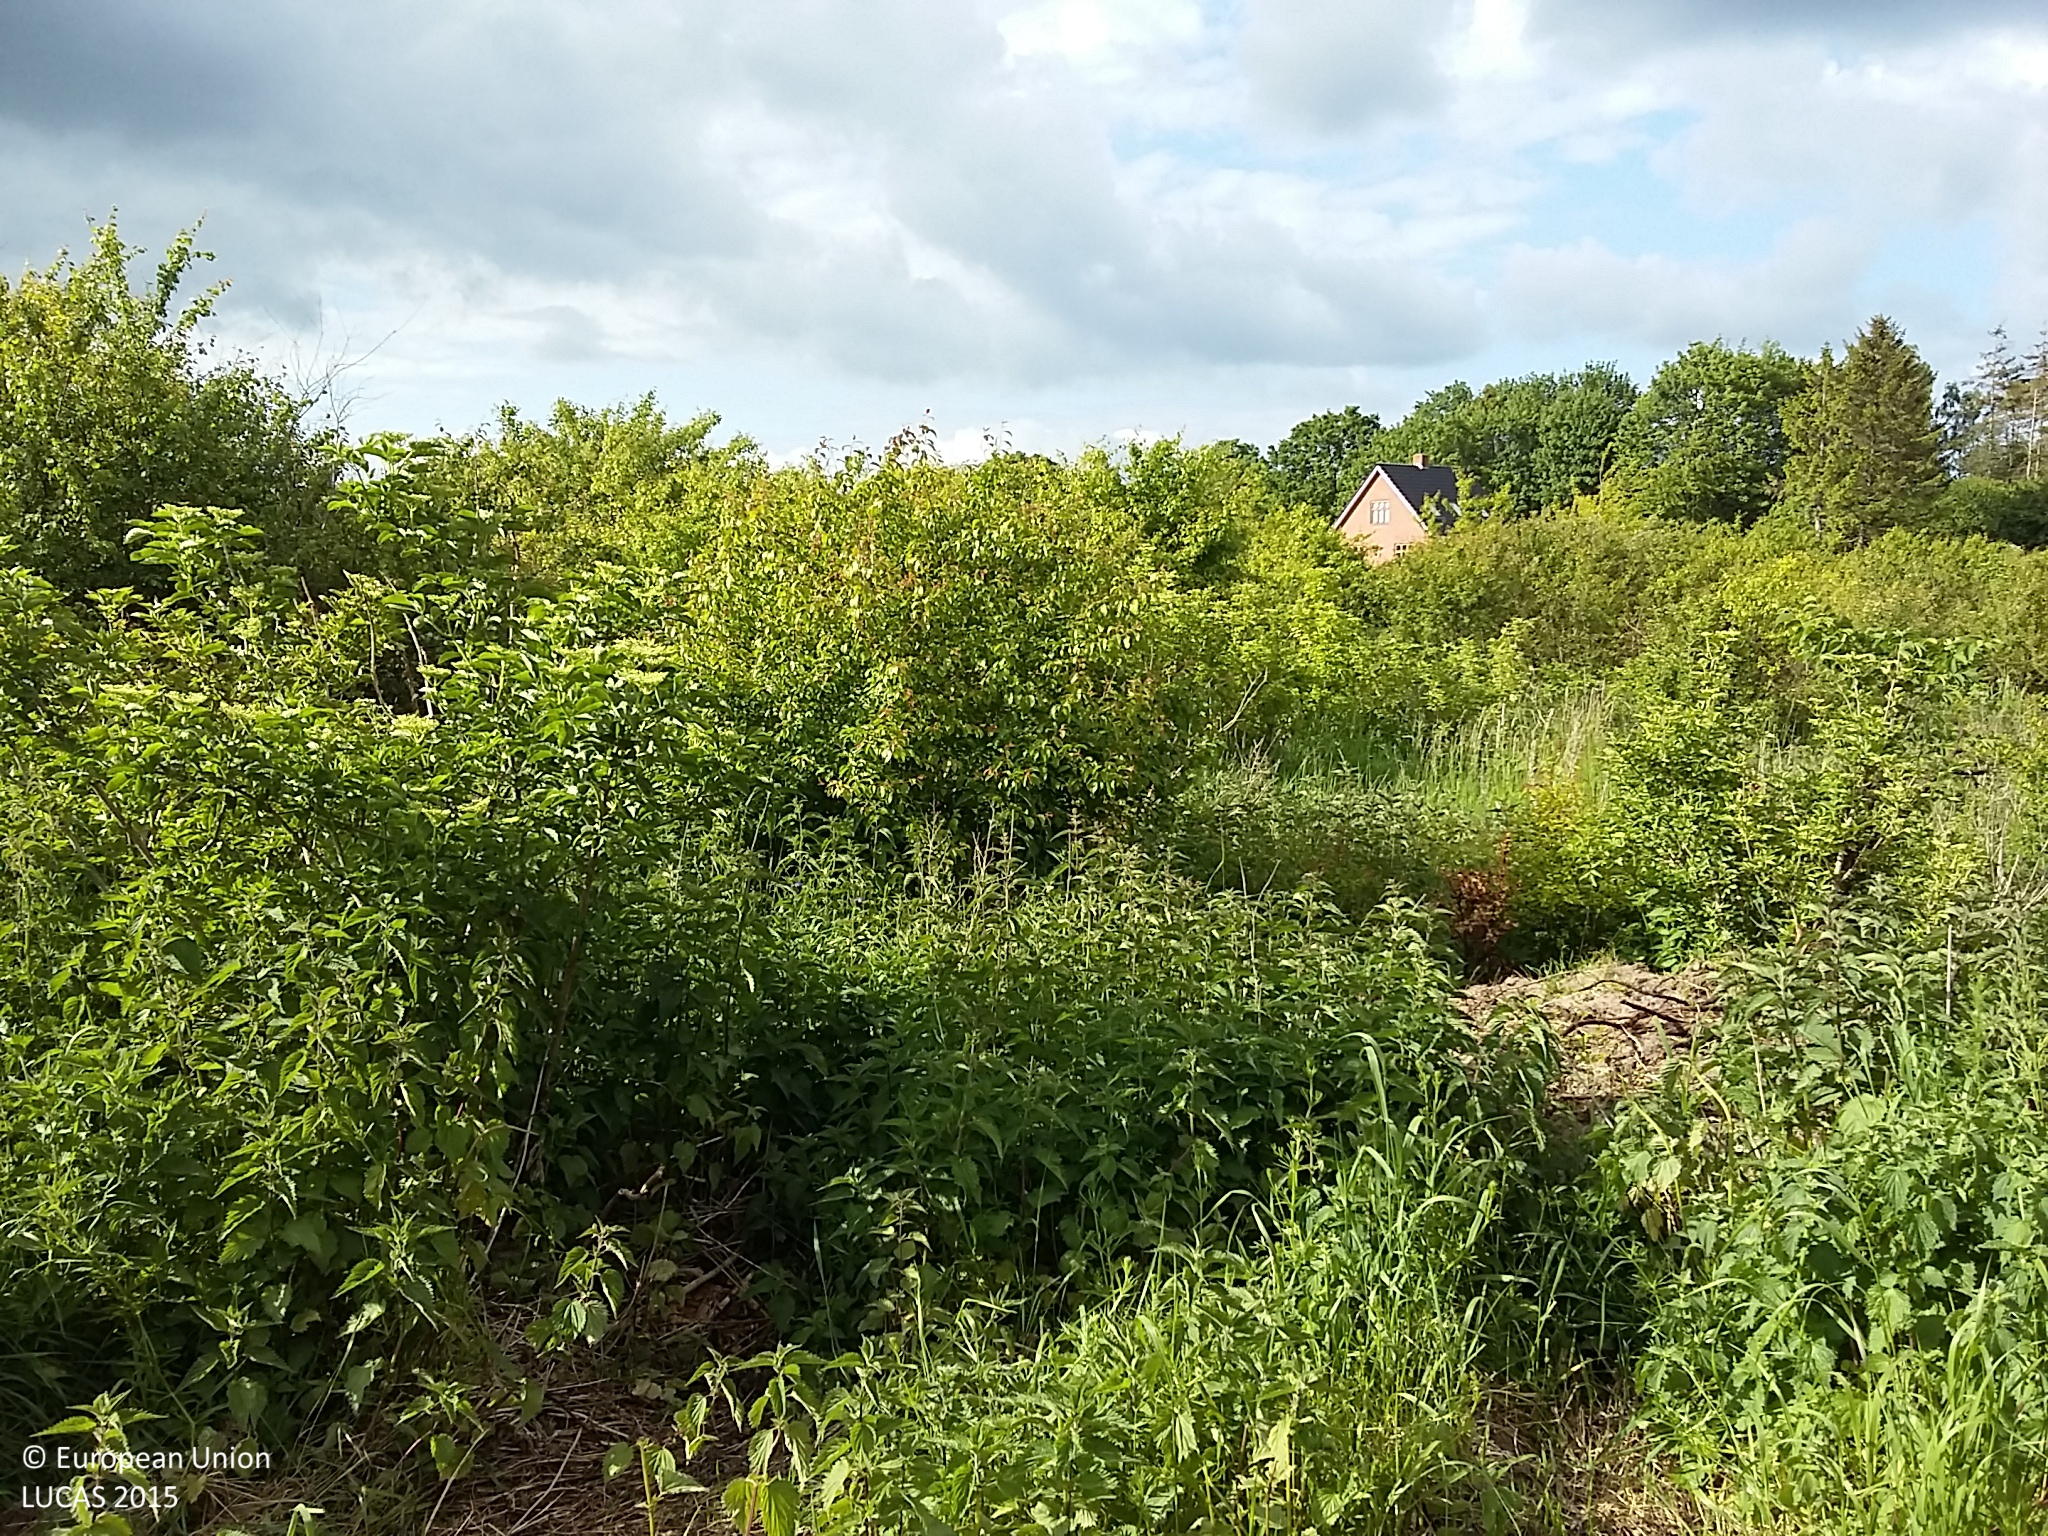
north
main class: Woodland
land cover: Broadleaved woodland
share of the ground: > 75 %
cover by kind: herbaceous plants 60 %, broadleaved forest trees 40 %
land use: Agriculture (excluding fallow land and kitchen gardens)
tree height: > 5 m
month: June
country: DK
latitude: 55.3408
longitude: 10.7404
